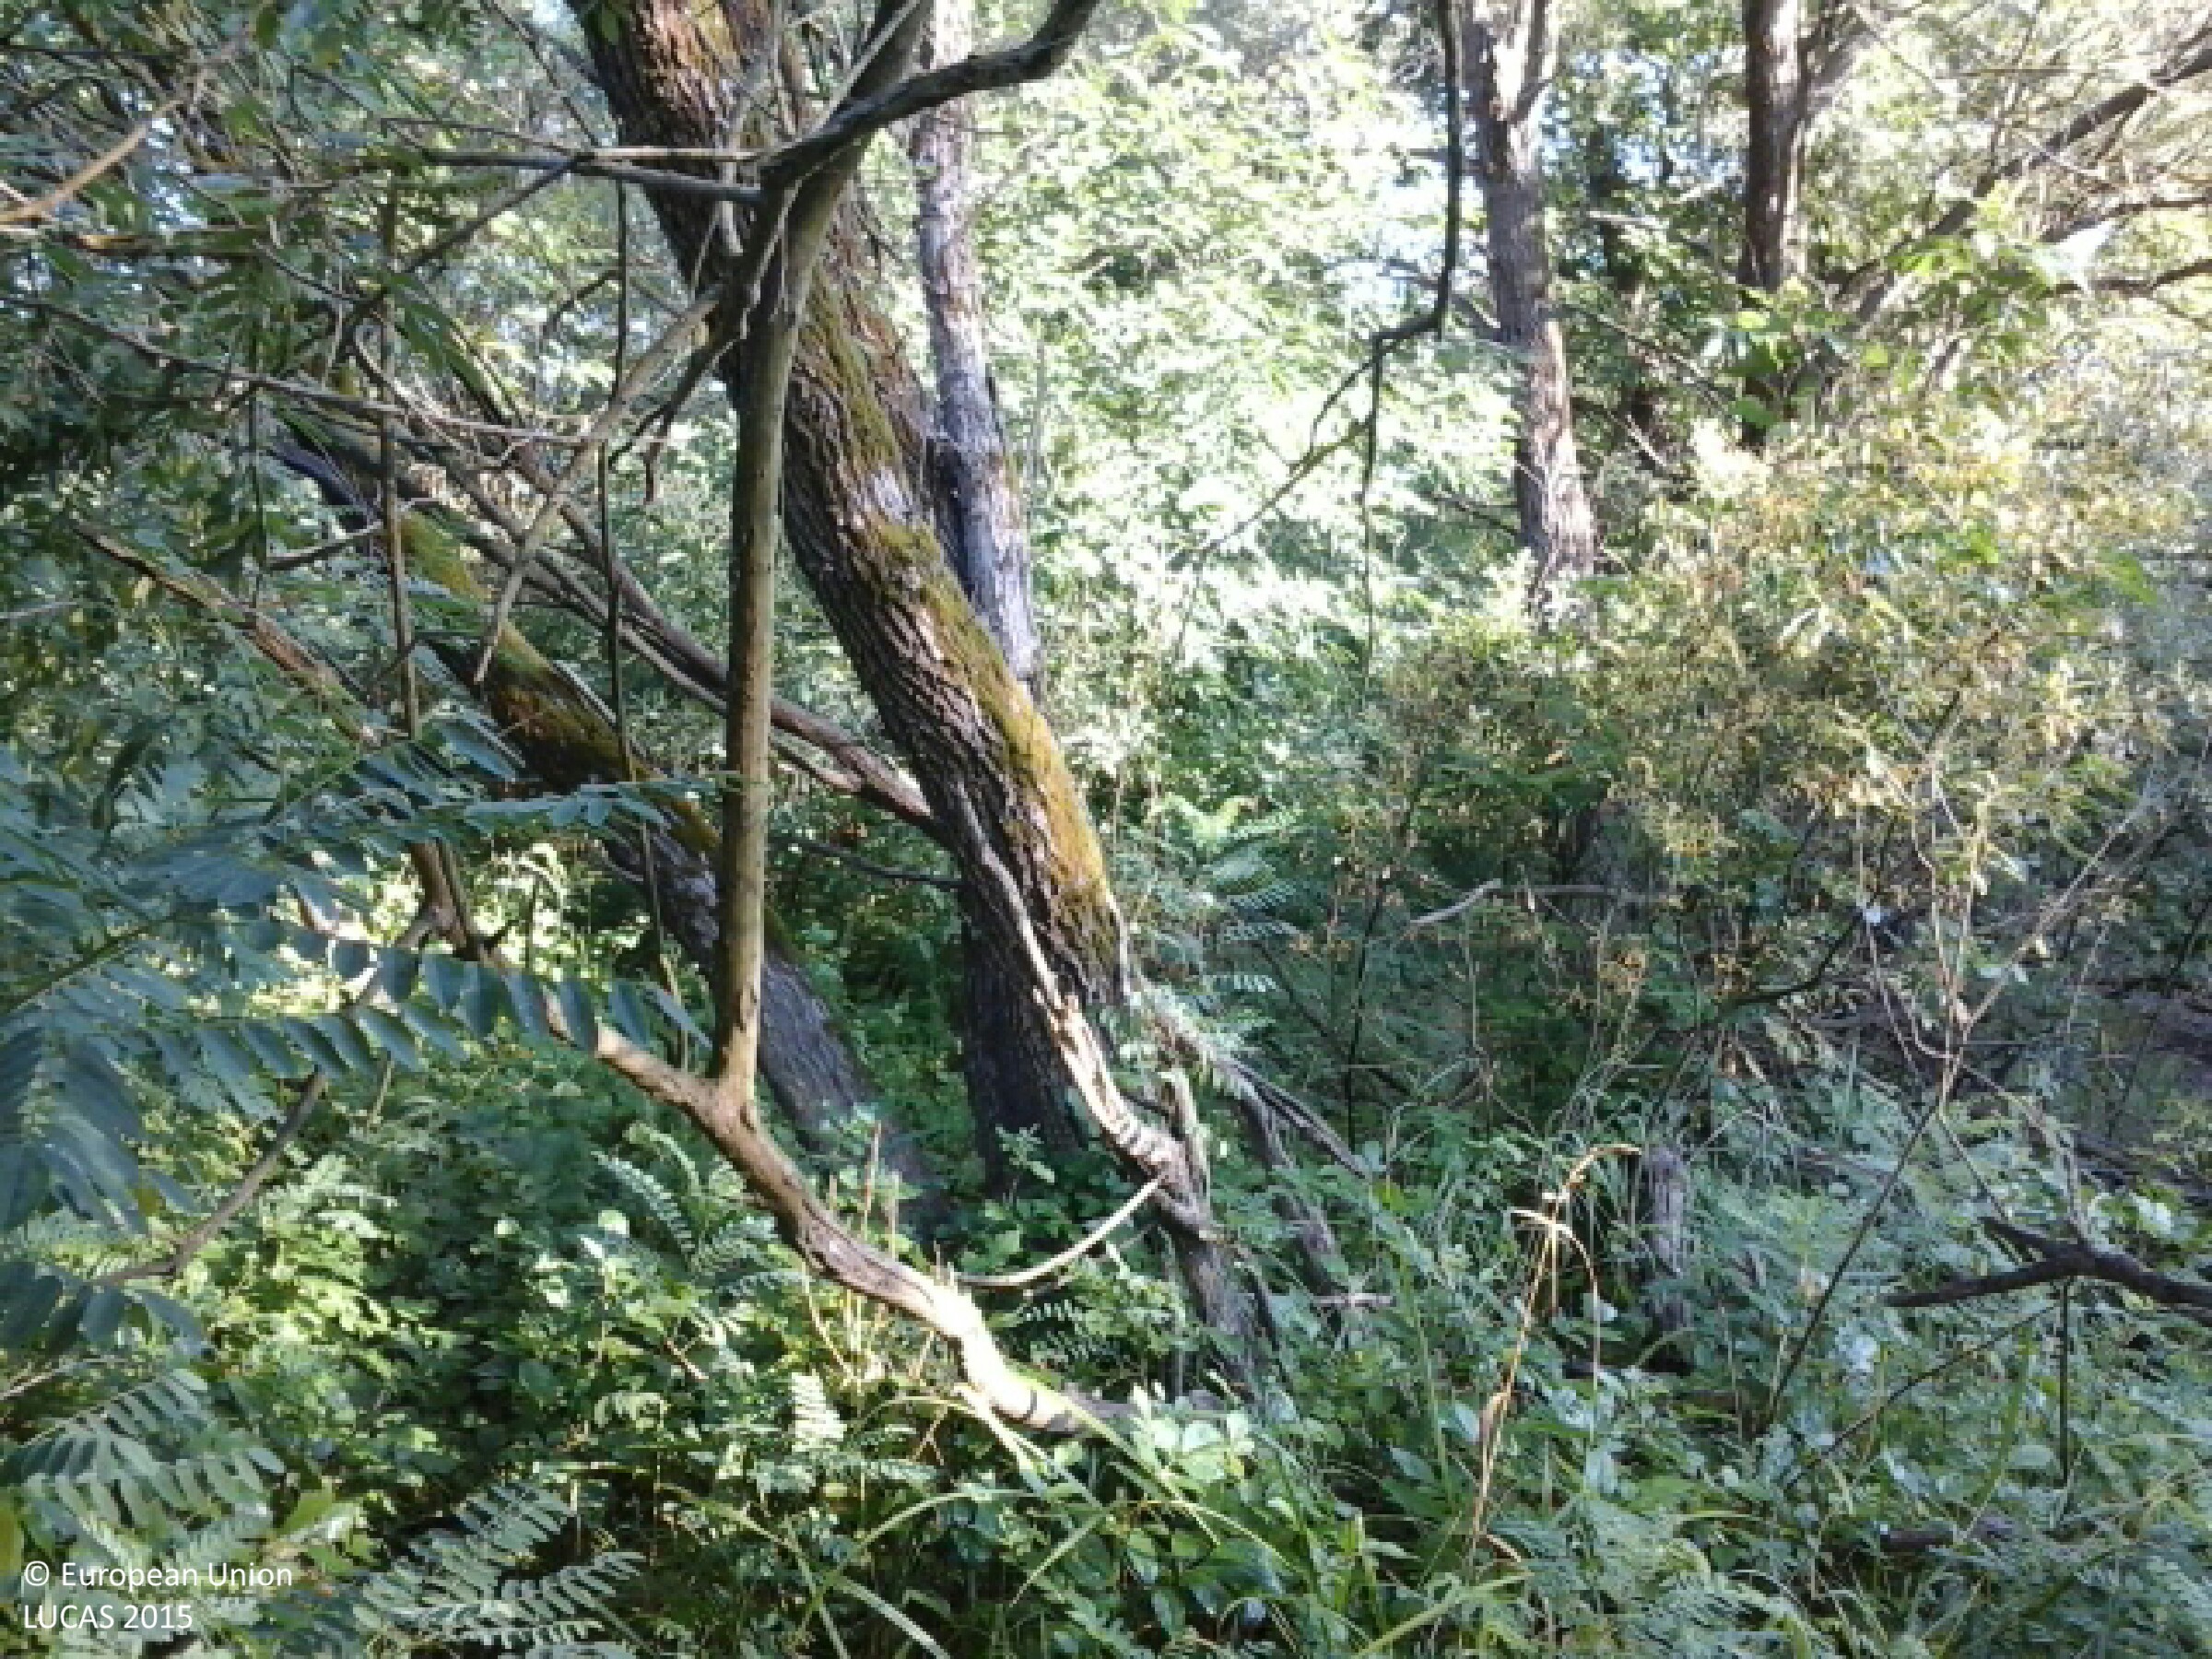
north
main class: Woodland
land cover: Broadleaved woodland
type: mesophytic deciduous forest
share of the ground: > 75 %
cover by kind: broadleaved forest trees 95 %, herbaceous plants 5 %
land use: Forestry
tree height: > 5 m
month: July
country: HU
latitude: 48.3527
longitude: 21.6130
